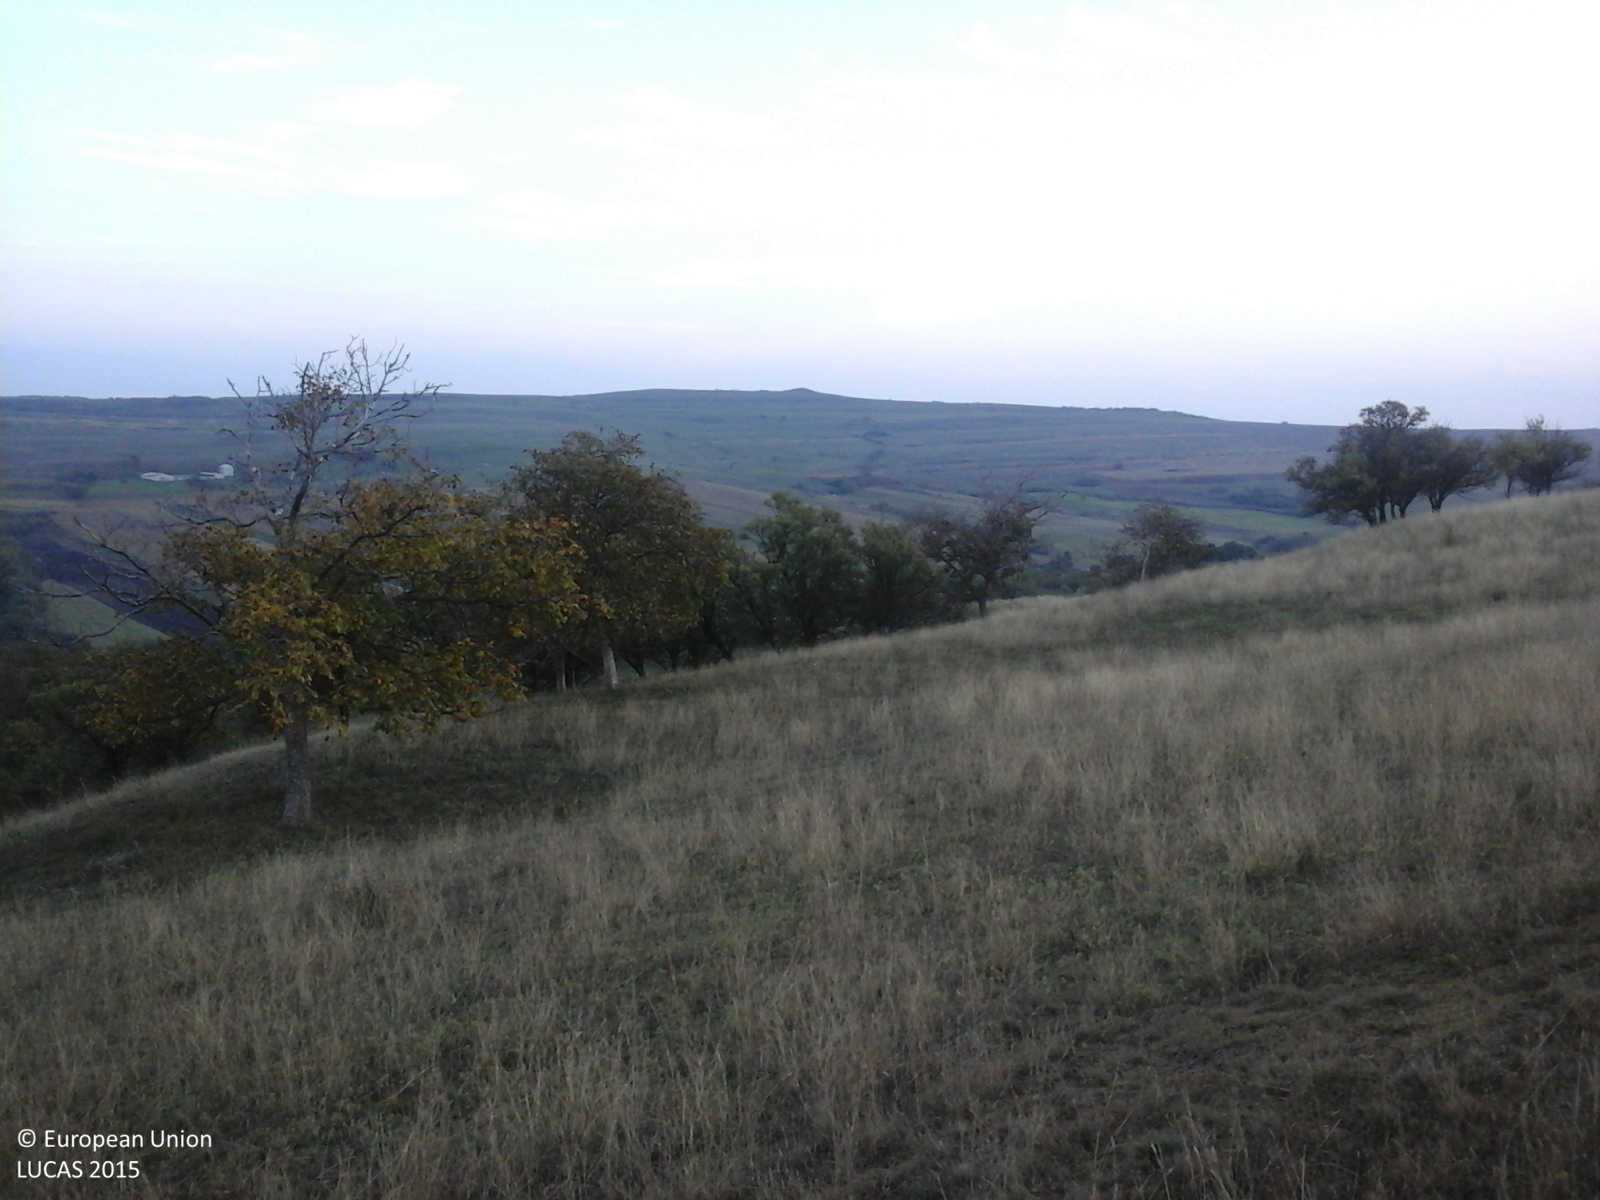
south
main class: Grassland
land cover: Grassland without tree/shrub cover
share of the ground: > 75 %
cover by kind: herbaceous plants 100 %
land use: Agriculture (excluding fallow land and kitchen gardens)
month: October
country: RO
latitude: 46.3153
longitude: 24.0367
